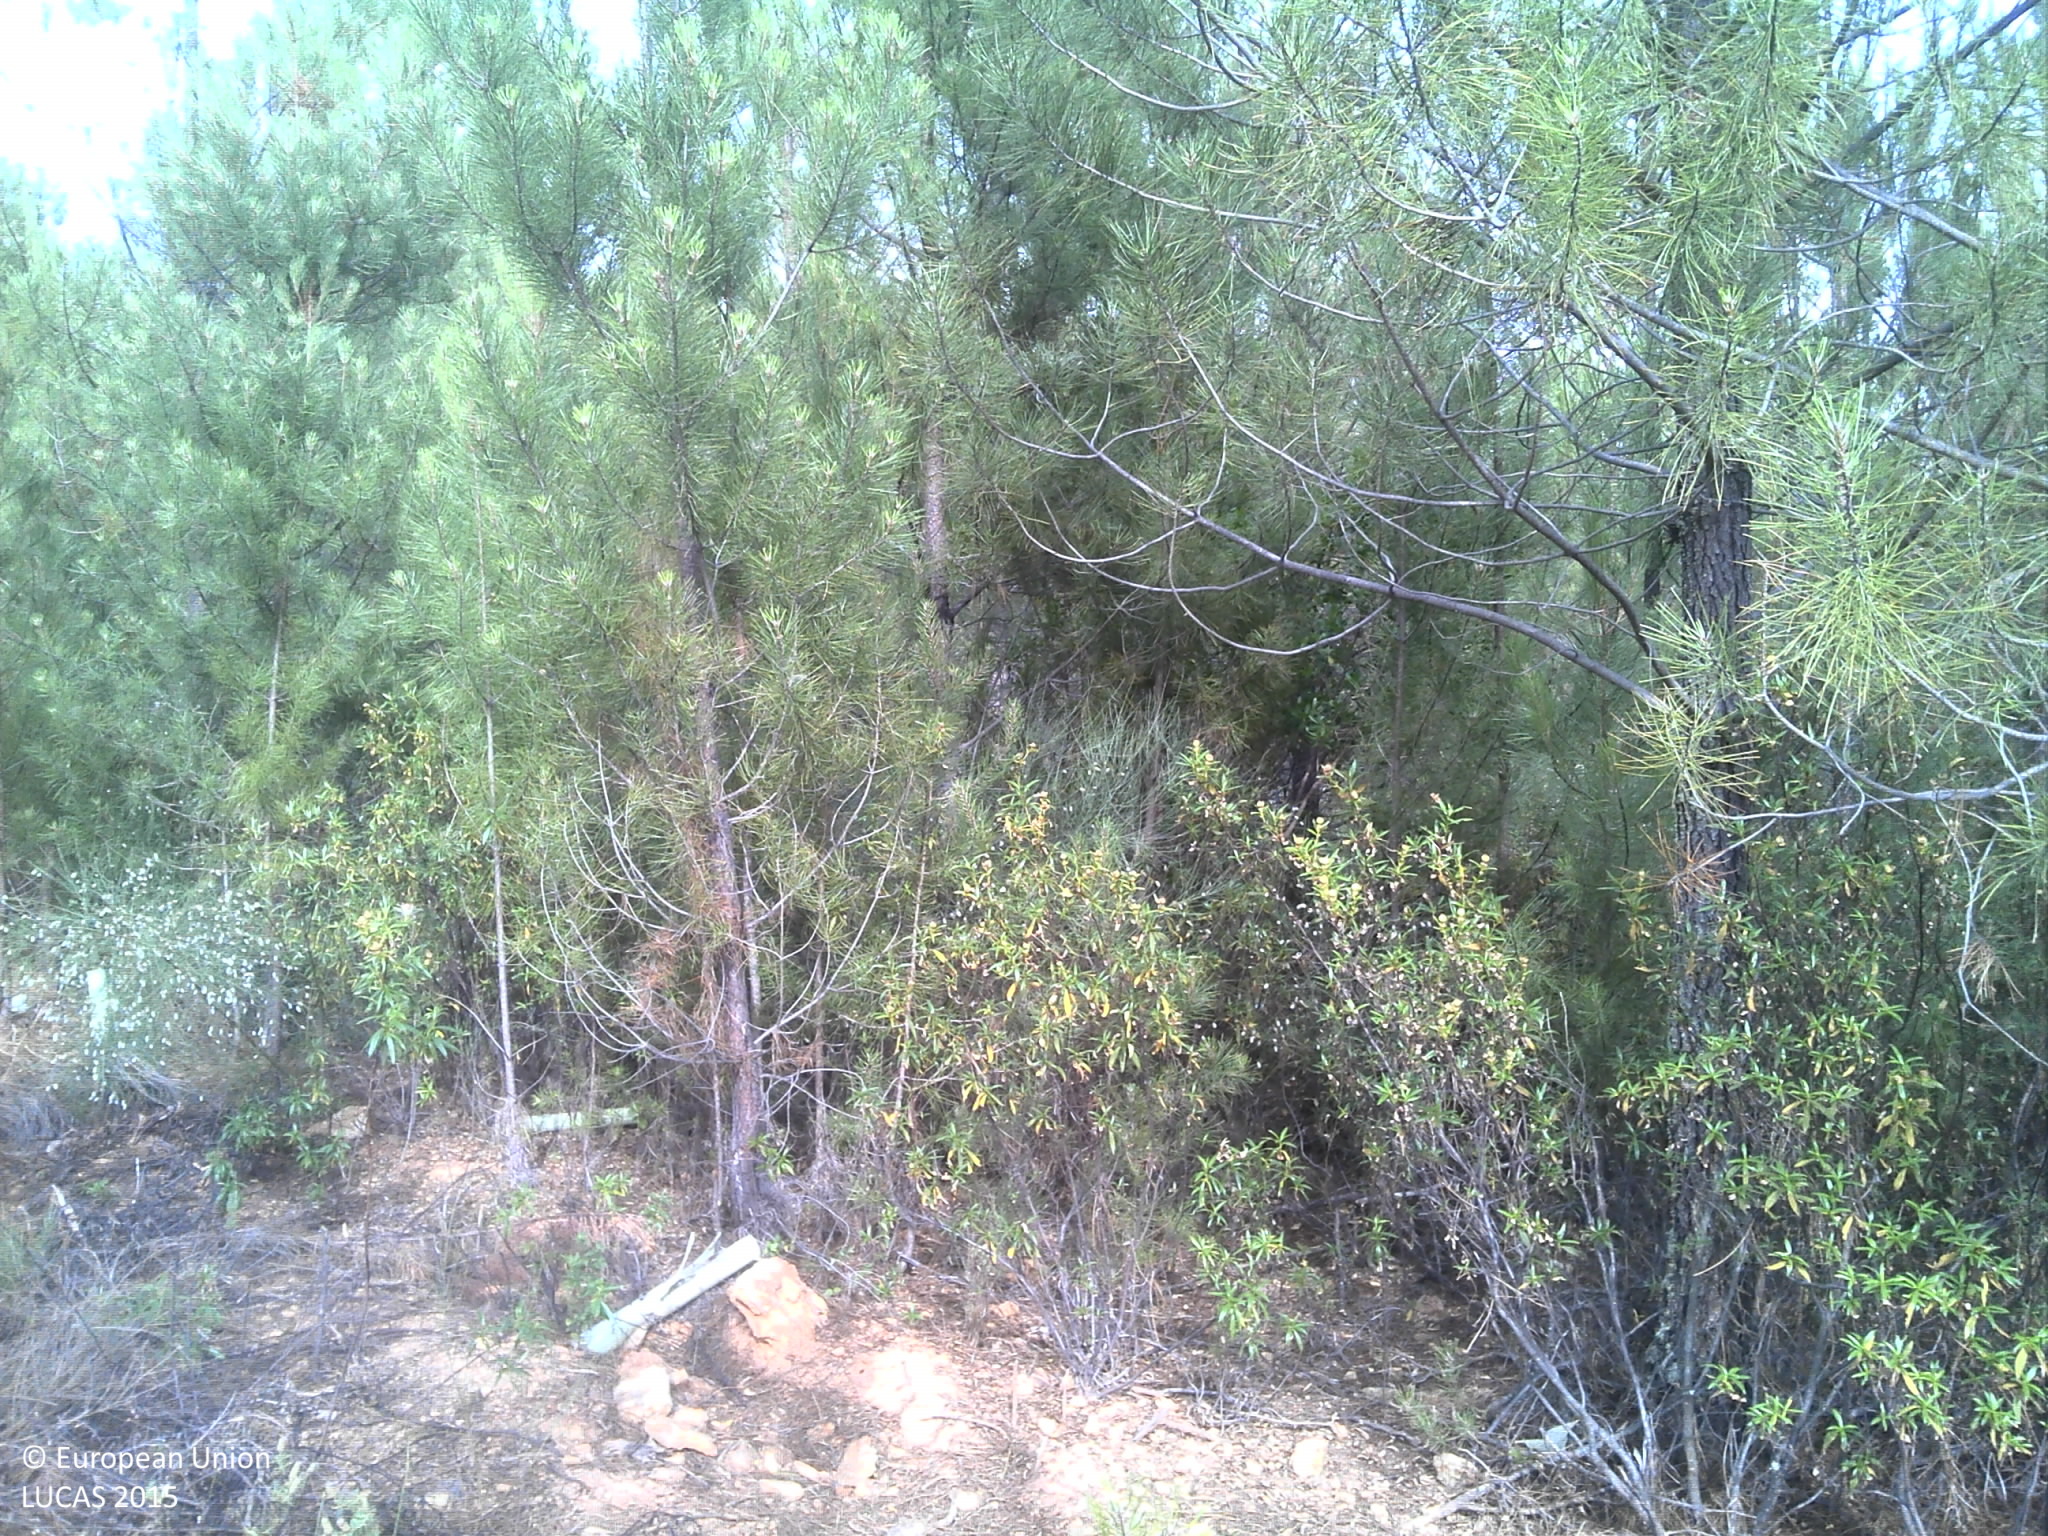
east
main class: Woodland
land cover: Pine dominated coniferous woodland
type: coniferous forest of the mediterranean region
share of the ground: 50 - 75 %
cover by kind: coniferous forest trees 50 %, shrubs 40 %, unconsolidated bare surface 5 %
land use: Forestry
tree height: > 5 m
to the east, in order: Pine dominated coniferous woodland; Rivers and streams; Pine dominated coniferous woodland
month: June
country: PT
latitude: 40.2108
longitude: -7.0978
